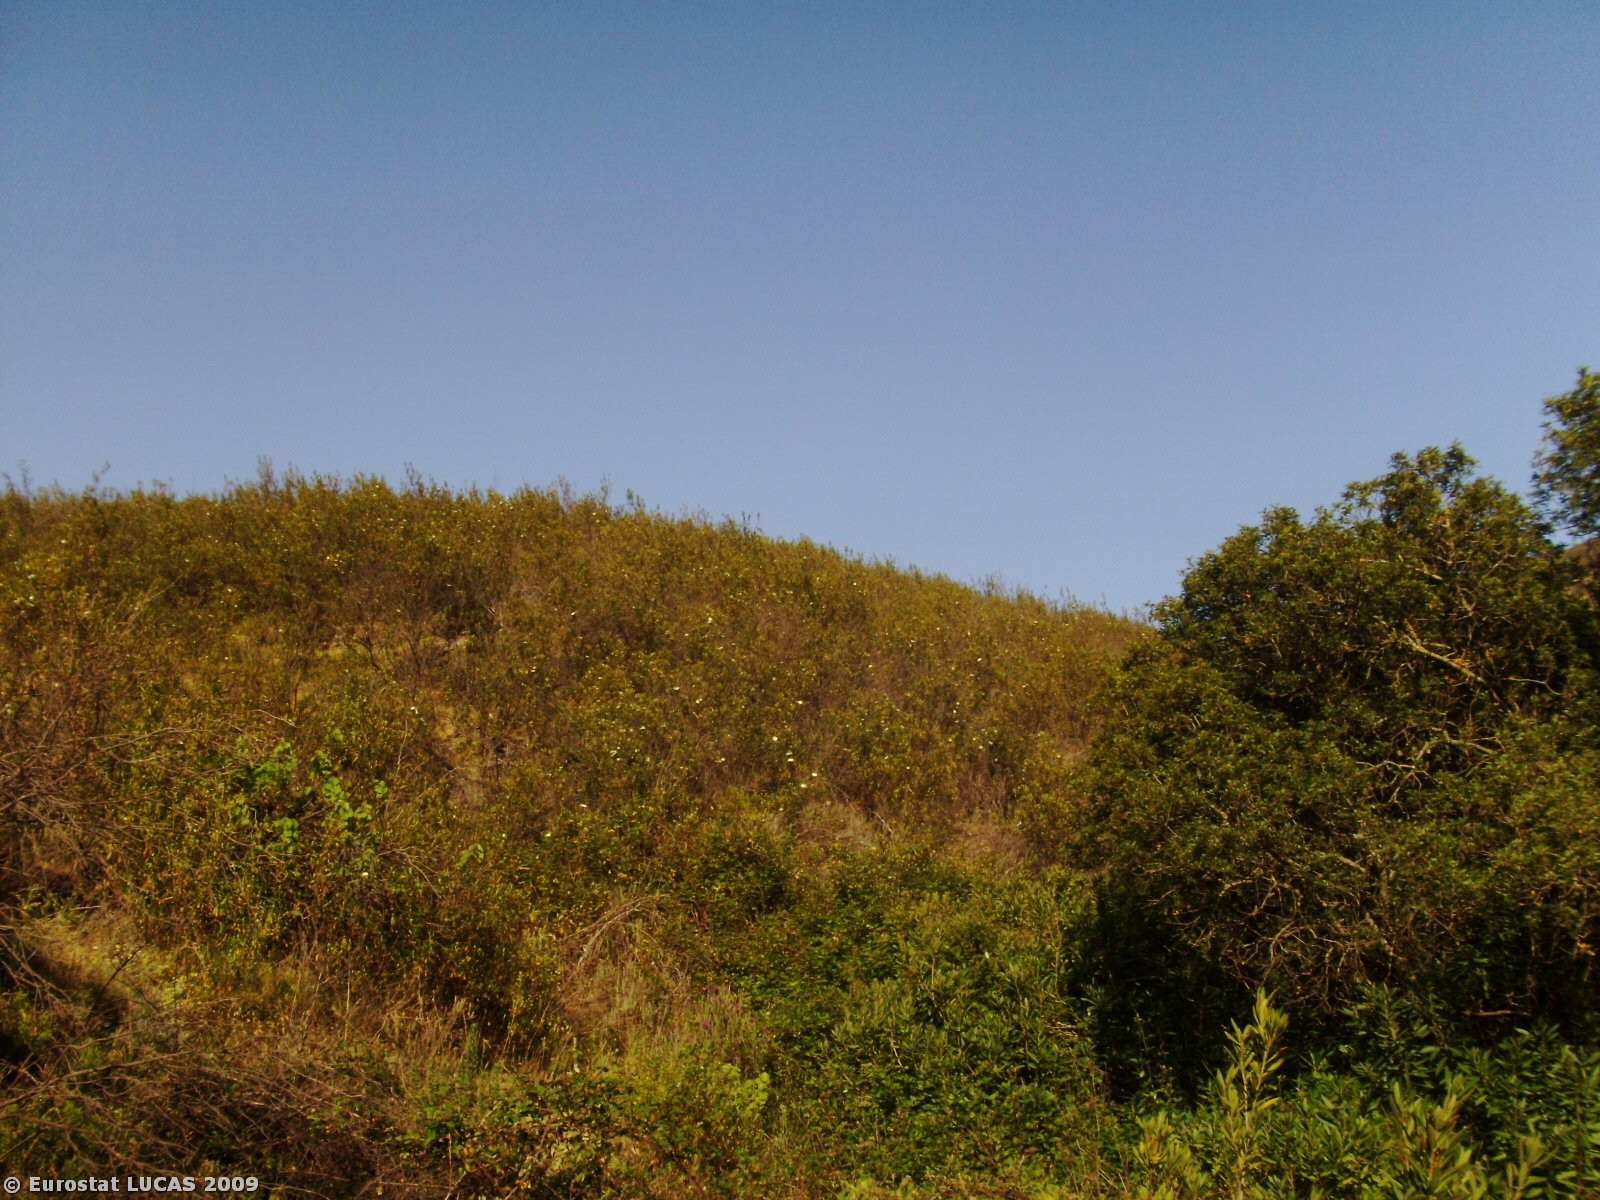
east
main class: Cropland
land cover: Vineyards
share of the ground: 10 - 25 %
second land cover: Spontaneously vegetated surfaces
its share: > 75 %
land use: Agriculture (excluding fallow land and kitchen gardens)
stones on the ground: 25 - 50 %
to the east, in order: Vineyards; Spontaneously vegetated surfaces; Vineyards; Rivers and streams; Shrubland with sparse tree cover; Spontaneously vegetated surfaces; Mixed woodland; Rivers and streams; Mixed woodland; Shrubland with sparse tree cover; Tracks; Shrubland with sparse tree cover; Tracks
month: May
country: PT
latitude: 37.3143
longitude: -7.6910
